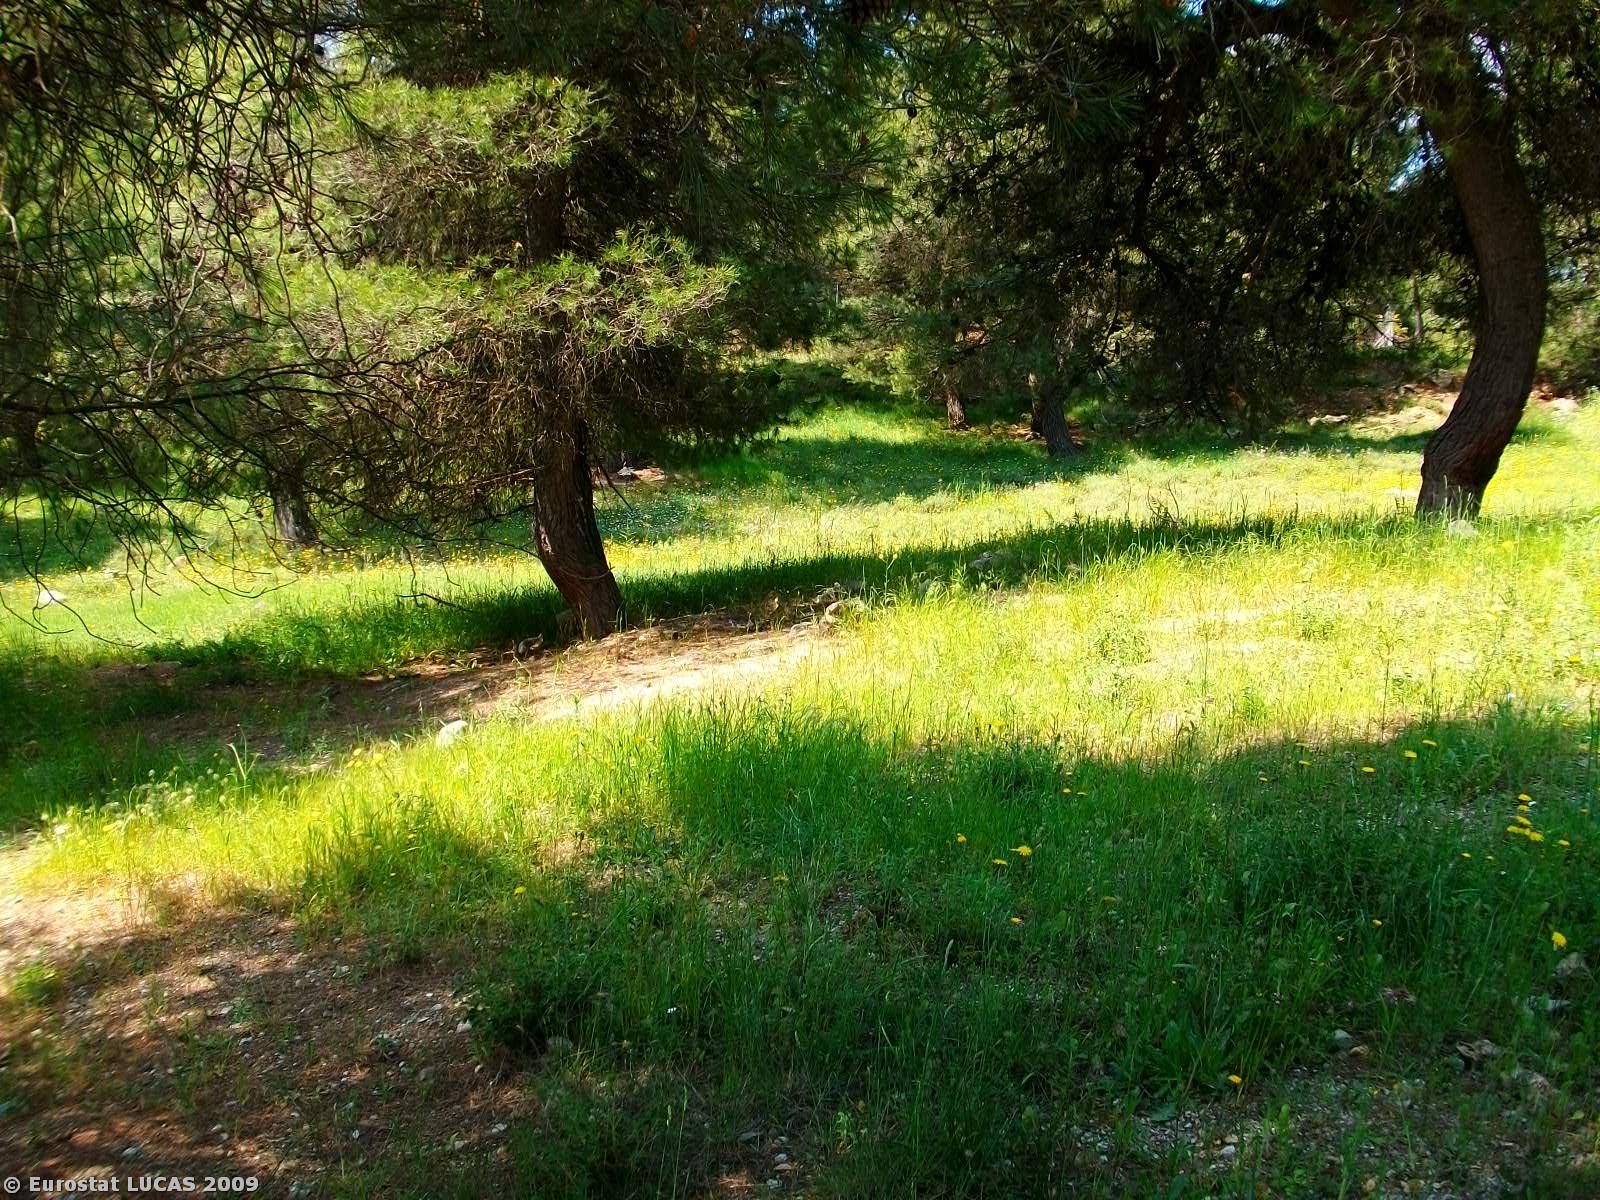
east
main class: Woodland
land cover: Coniferous woodland
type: coniferous forest of the mediterranean region
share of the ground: > 75 %
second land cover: Grassland with sparse tree/shrub cover
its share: 10 - 25 %
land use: Forestry
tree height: > 5 m
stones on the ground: 25 - 50 %
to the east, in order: Coniferous woodland; Grassland with sparse tree/shrub cover; Paved roads, cycling and walking lanes; Coniferous woodland
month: May
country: GR
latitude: 38.2030
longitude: 23.8138
